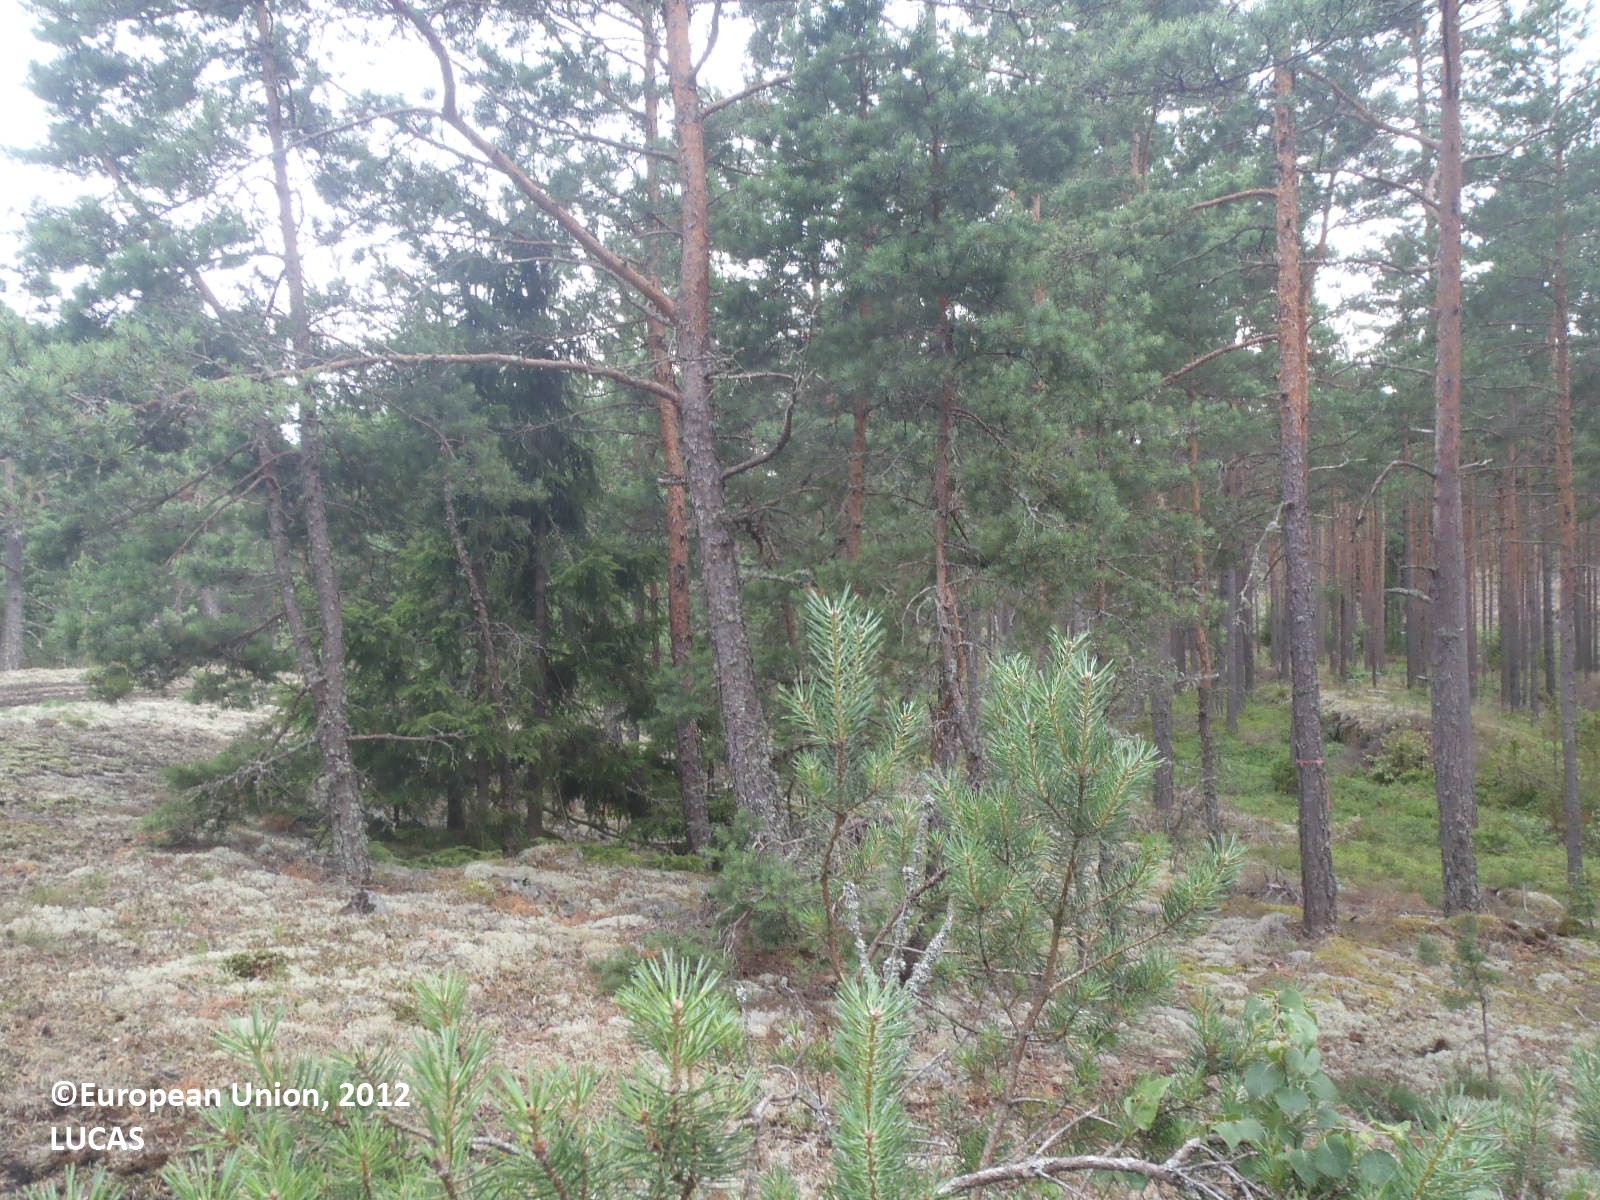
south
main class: Woodland
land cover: Pine dominated coniferous woodland
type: boreal forest
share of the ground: 25 - 50 %
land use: Forestry
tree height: > 5 m
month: July
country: FI
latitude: 60.3232
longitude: 21.9967
